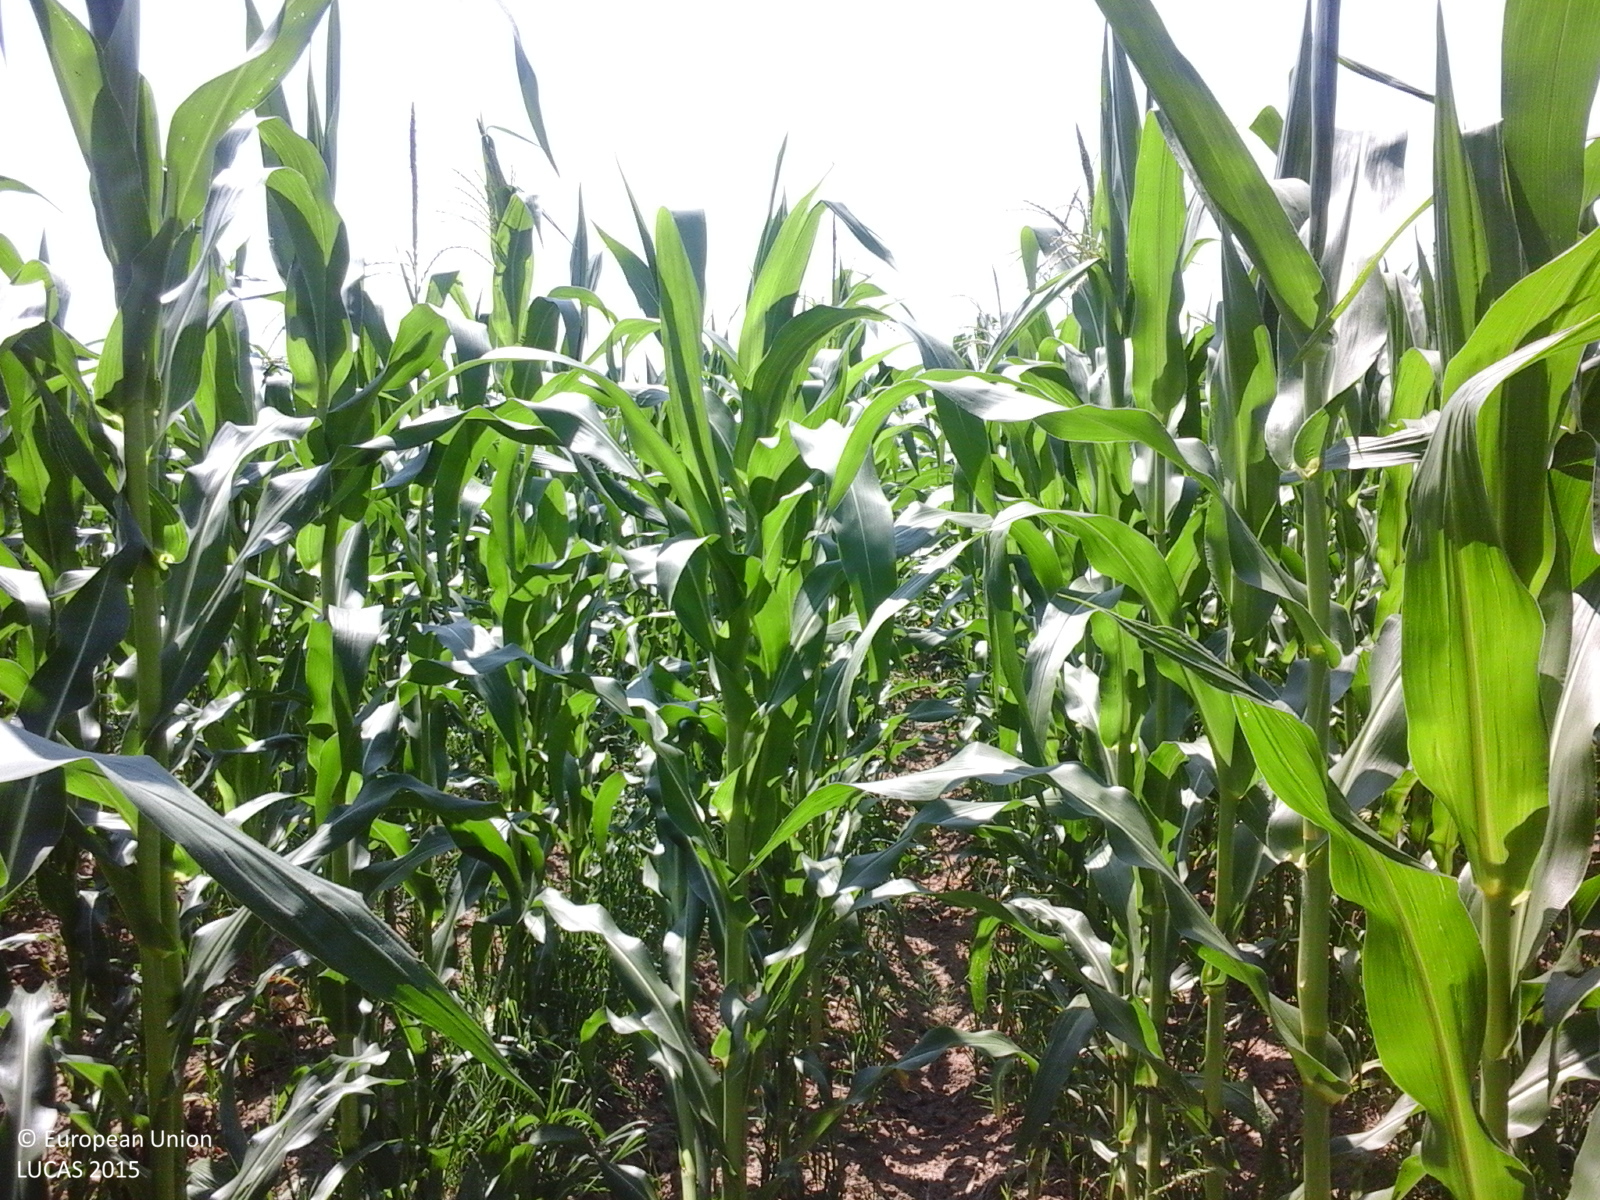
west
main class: Cropland
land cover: Maize
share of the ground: > 75 %
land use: Agriculture (excluding fallow land and kitchen gardens)
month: July
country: RO
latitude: 44.9914
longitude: 24.7558
